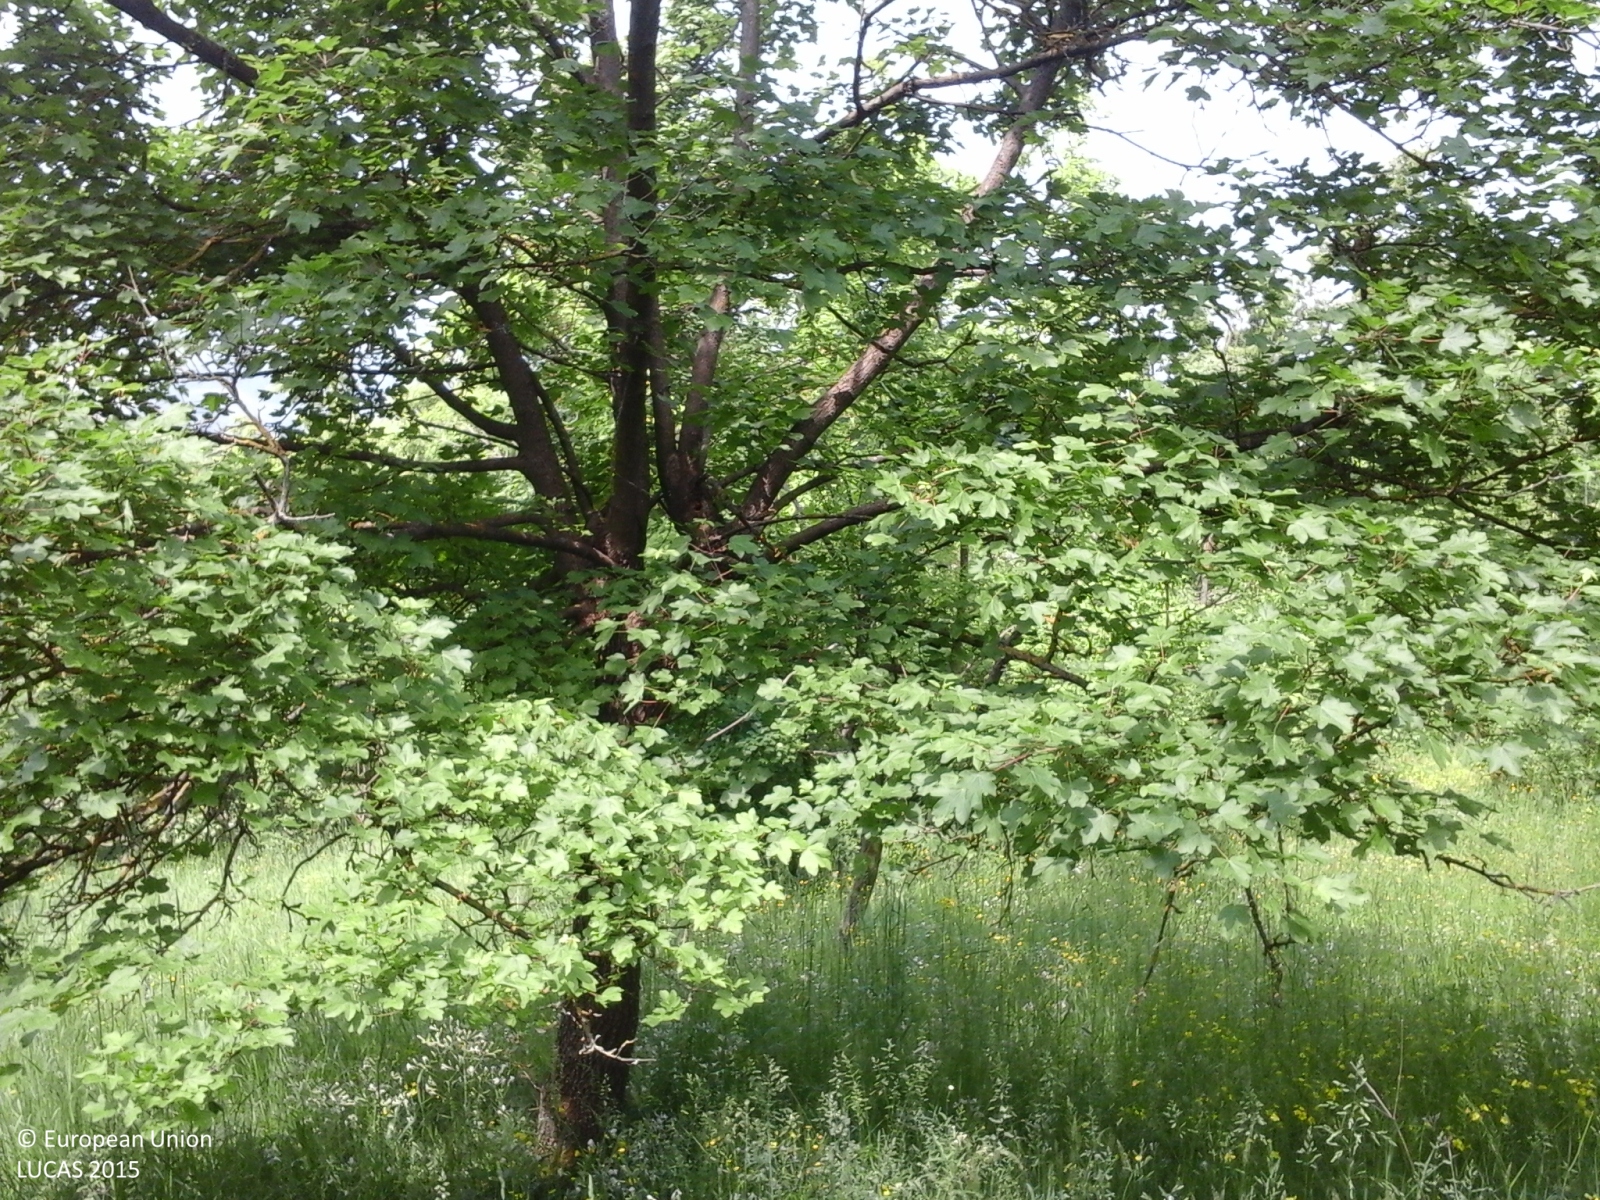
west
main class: Woodland
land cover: Broadleaved woodland
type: thermophilous deciduous forest
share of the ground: > 75 %
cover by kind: broadleaved forest trees 100 %
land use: Forestry
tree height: > 5 m
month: May
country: IT
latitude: 44.4558
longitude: 10.7900
